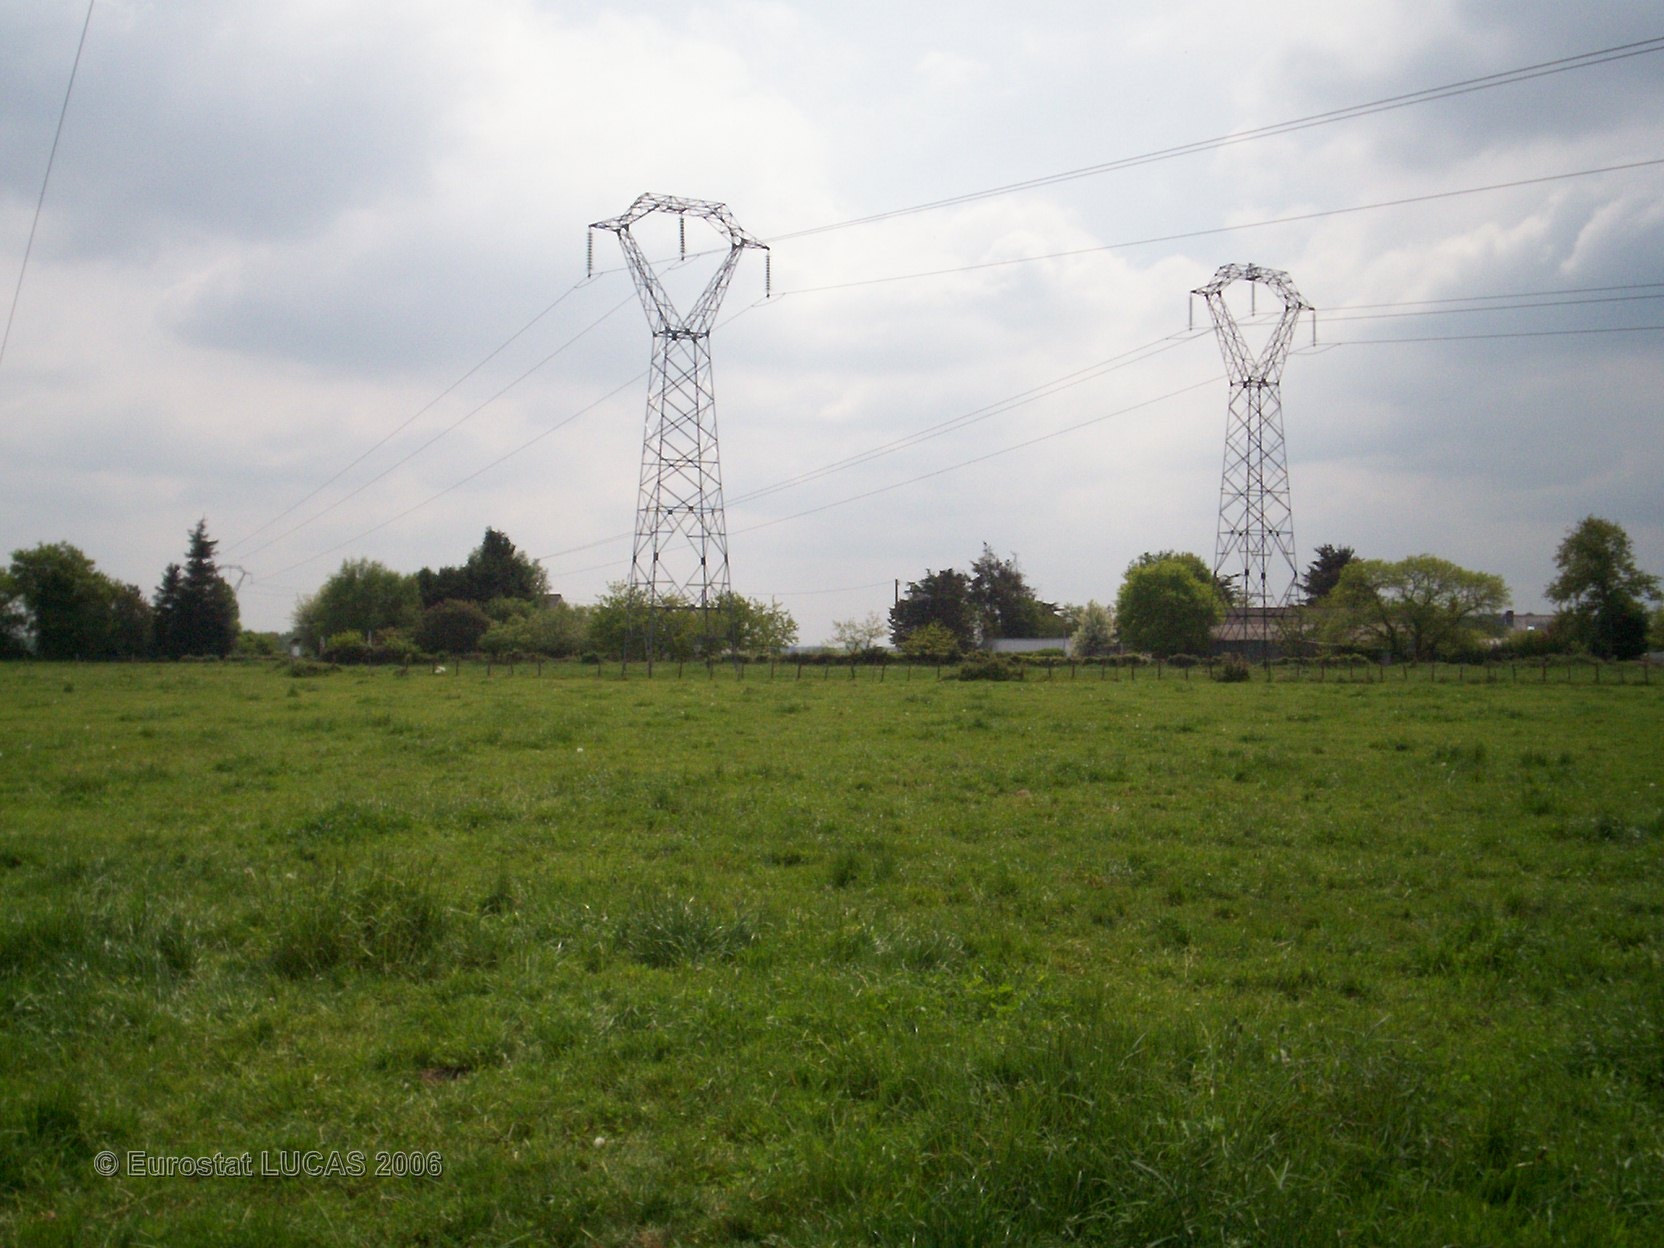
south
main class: Grassland
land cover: Grassland without tree/shrub cover
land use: Agriculture (excluding fallow land and kitchen gardens)
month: May
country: FR
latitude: 47.5390
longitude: -2.2356
